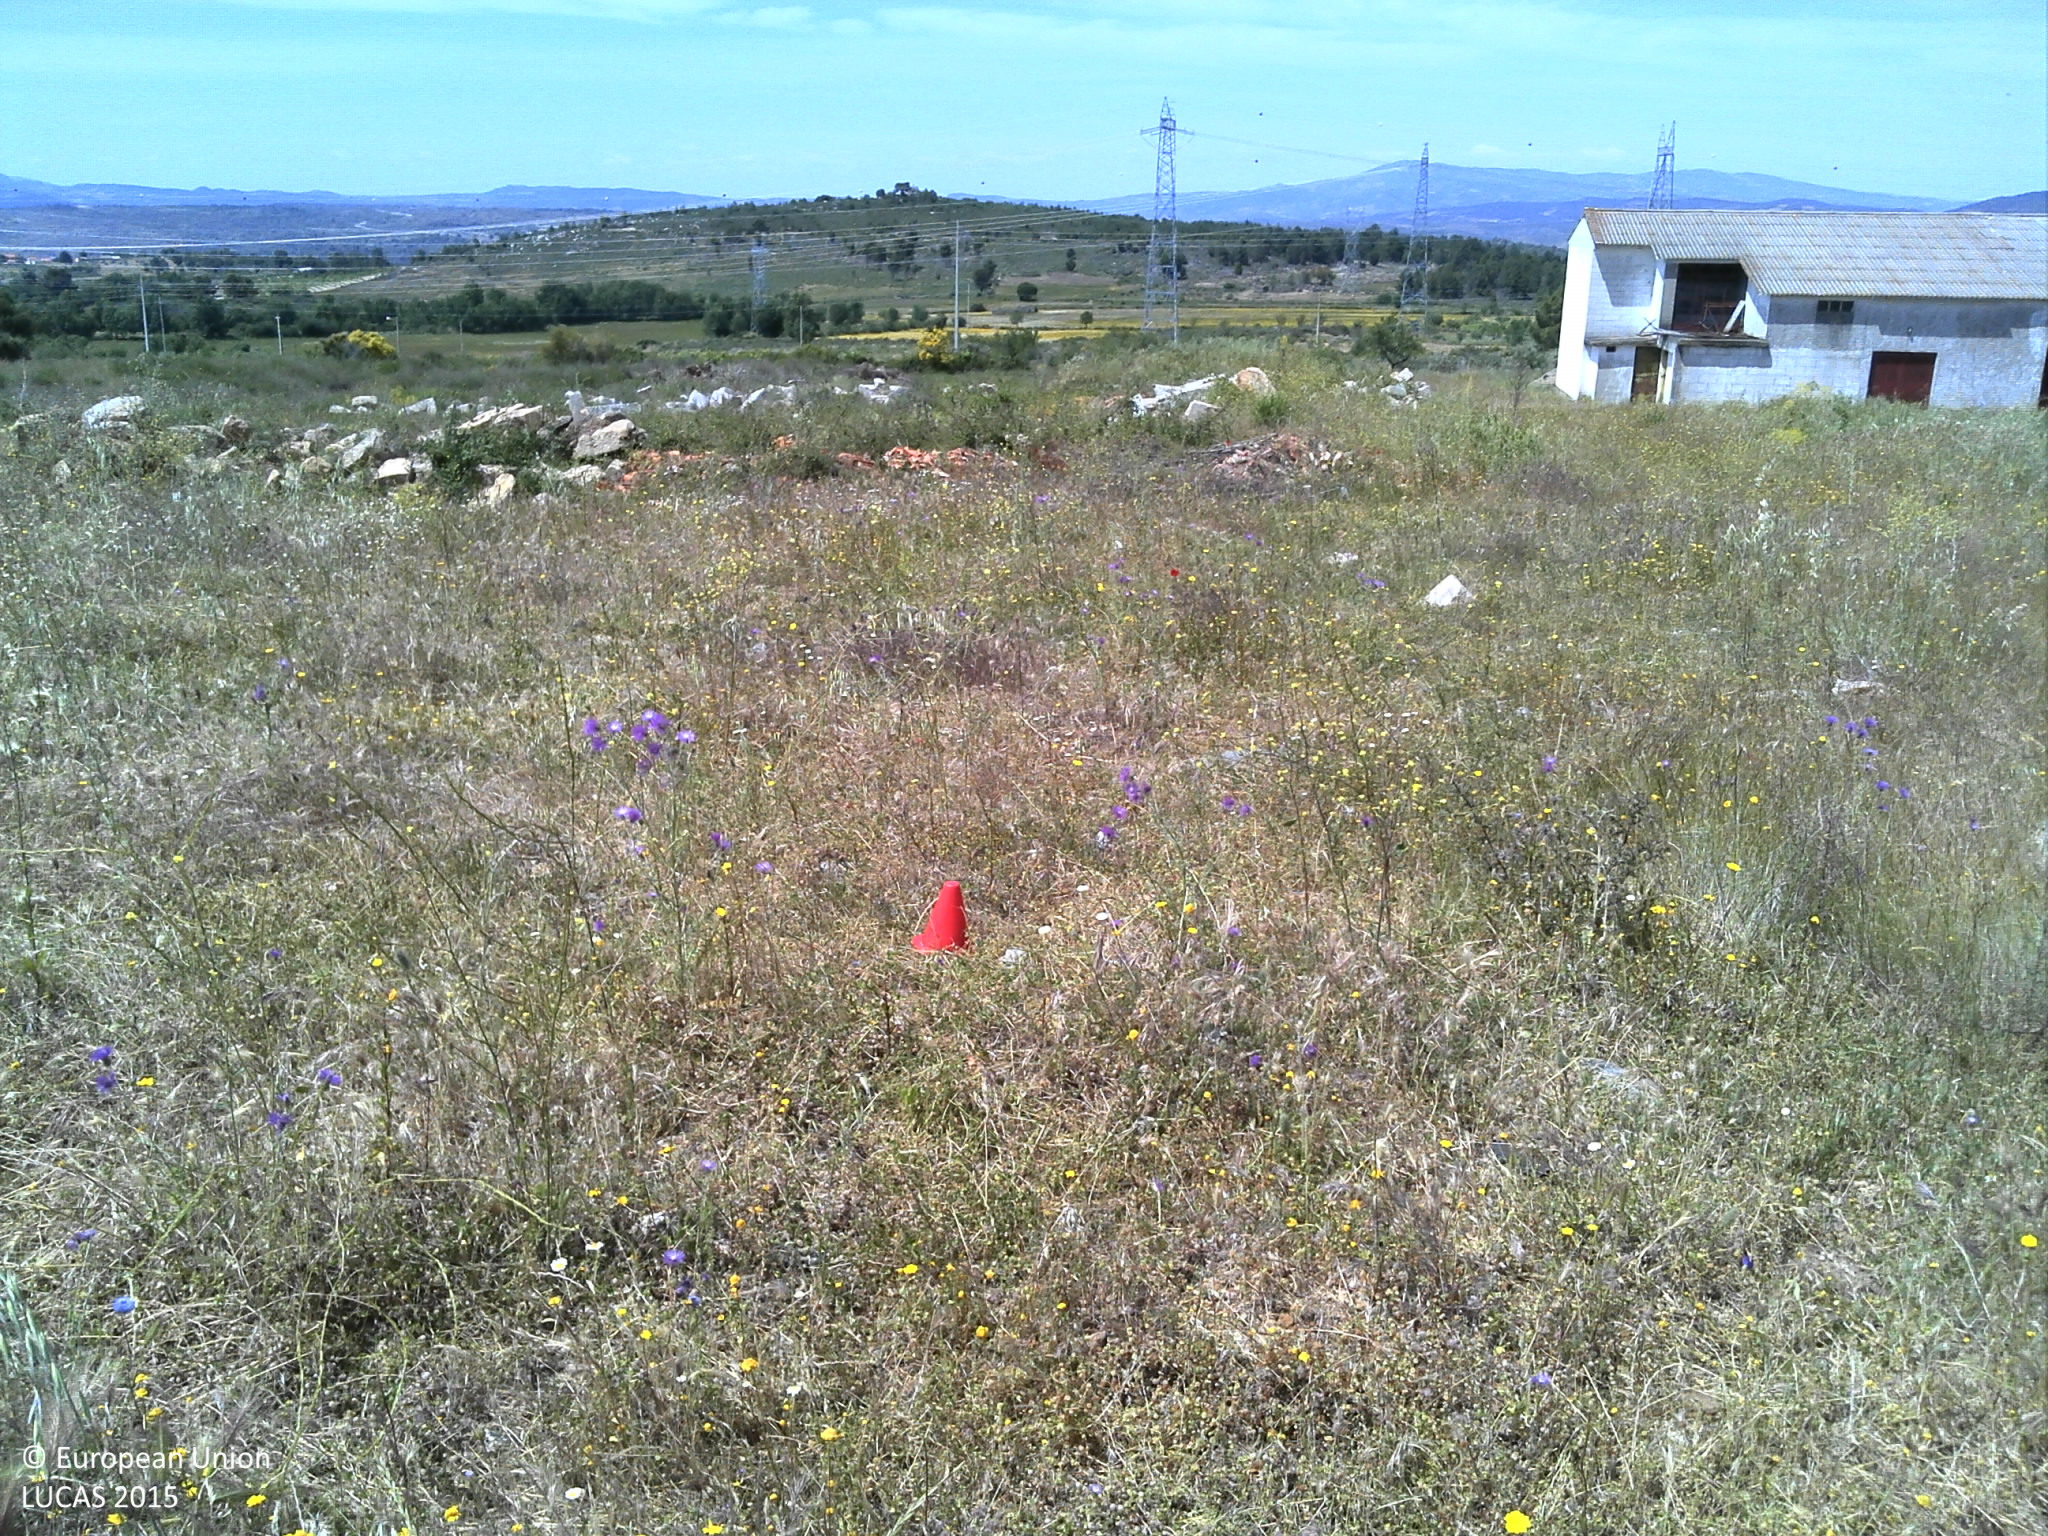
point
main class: Grassland
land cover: Grassland without tree/shrub cover
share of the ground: > 75 %
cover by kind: herbaceous plants 95 %, unconsolidated bare surface 5 %
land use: Agriculture (excluding fallow land and kitchen gardens)
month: May
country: PT
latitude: 41.1855
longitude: -7.0033
